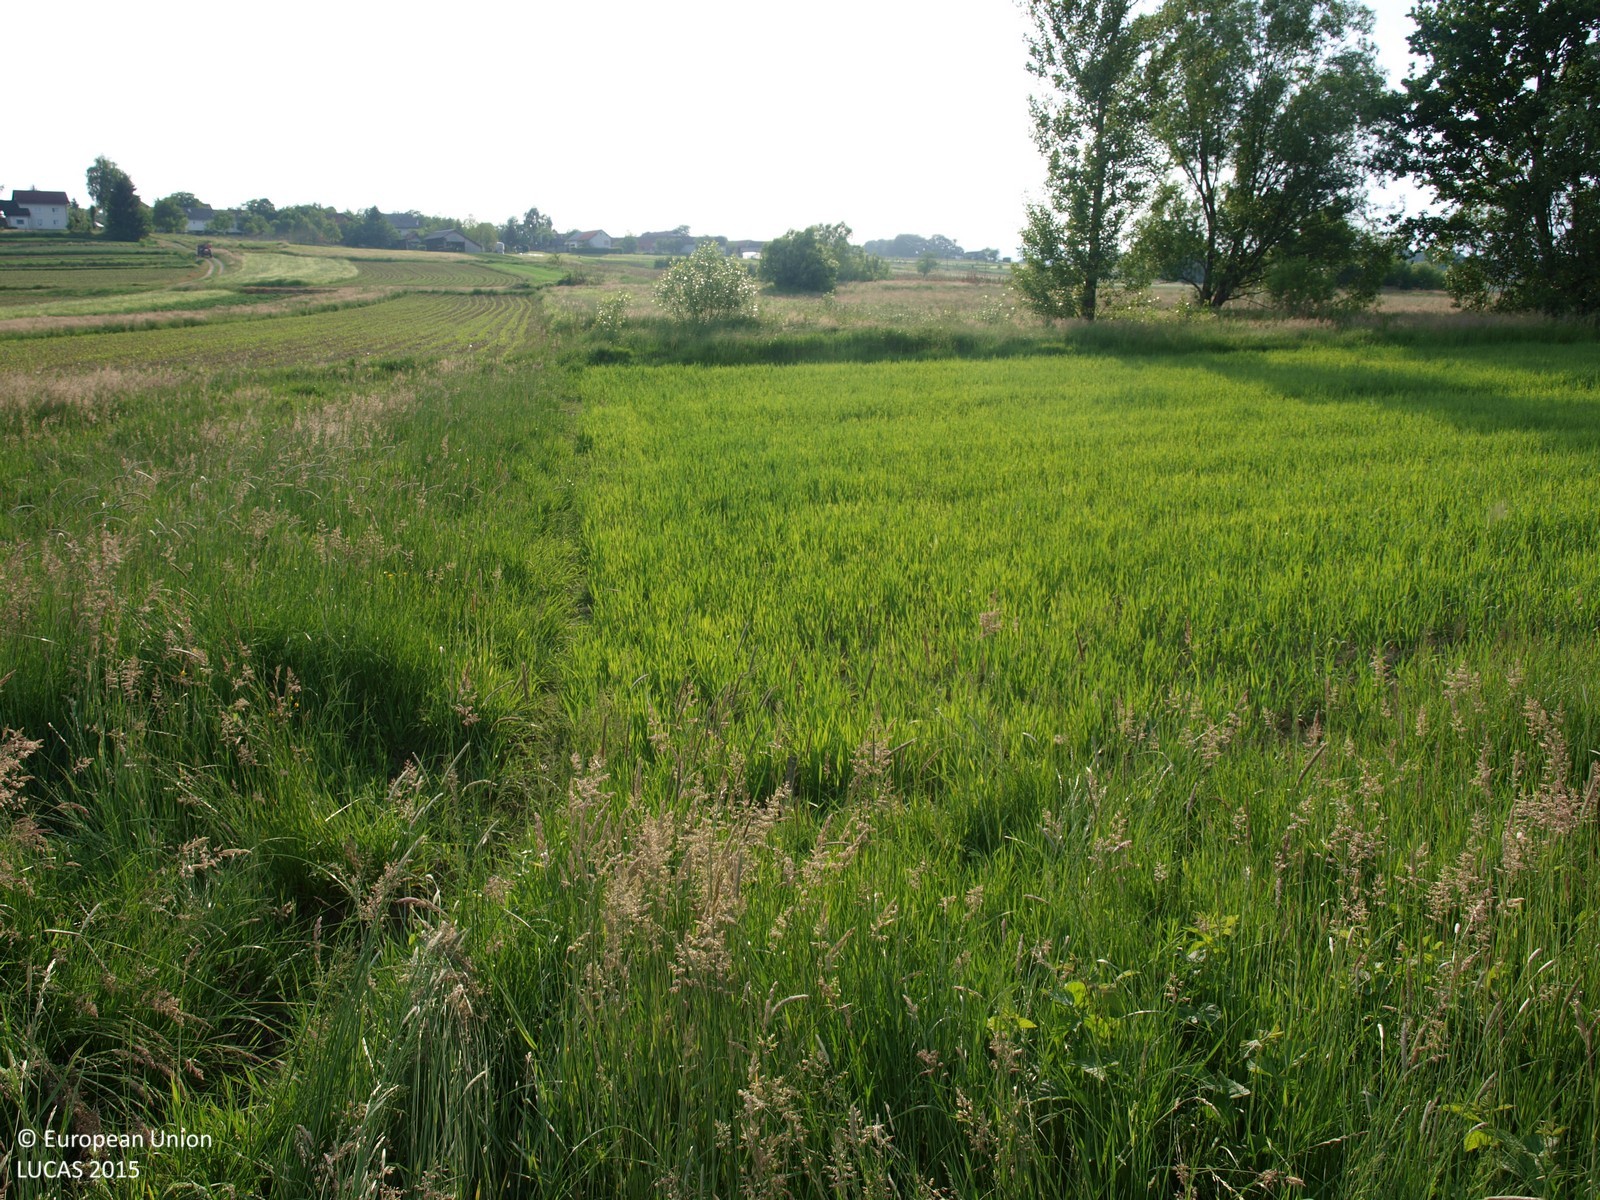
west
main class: Grassland
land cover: Spontaneously vegetated surfaces
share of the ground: > 75 %
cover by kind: herbaceous plants 95 %, shrubs 5 %
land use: Semi-natural and natural areas not in use
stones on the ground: < 10 %
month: May
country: HR
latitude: 46.2474
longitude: 16.1344
